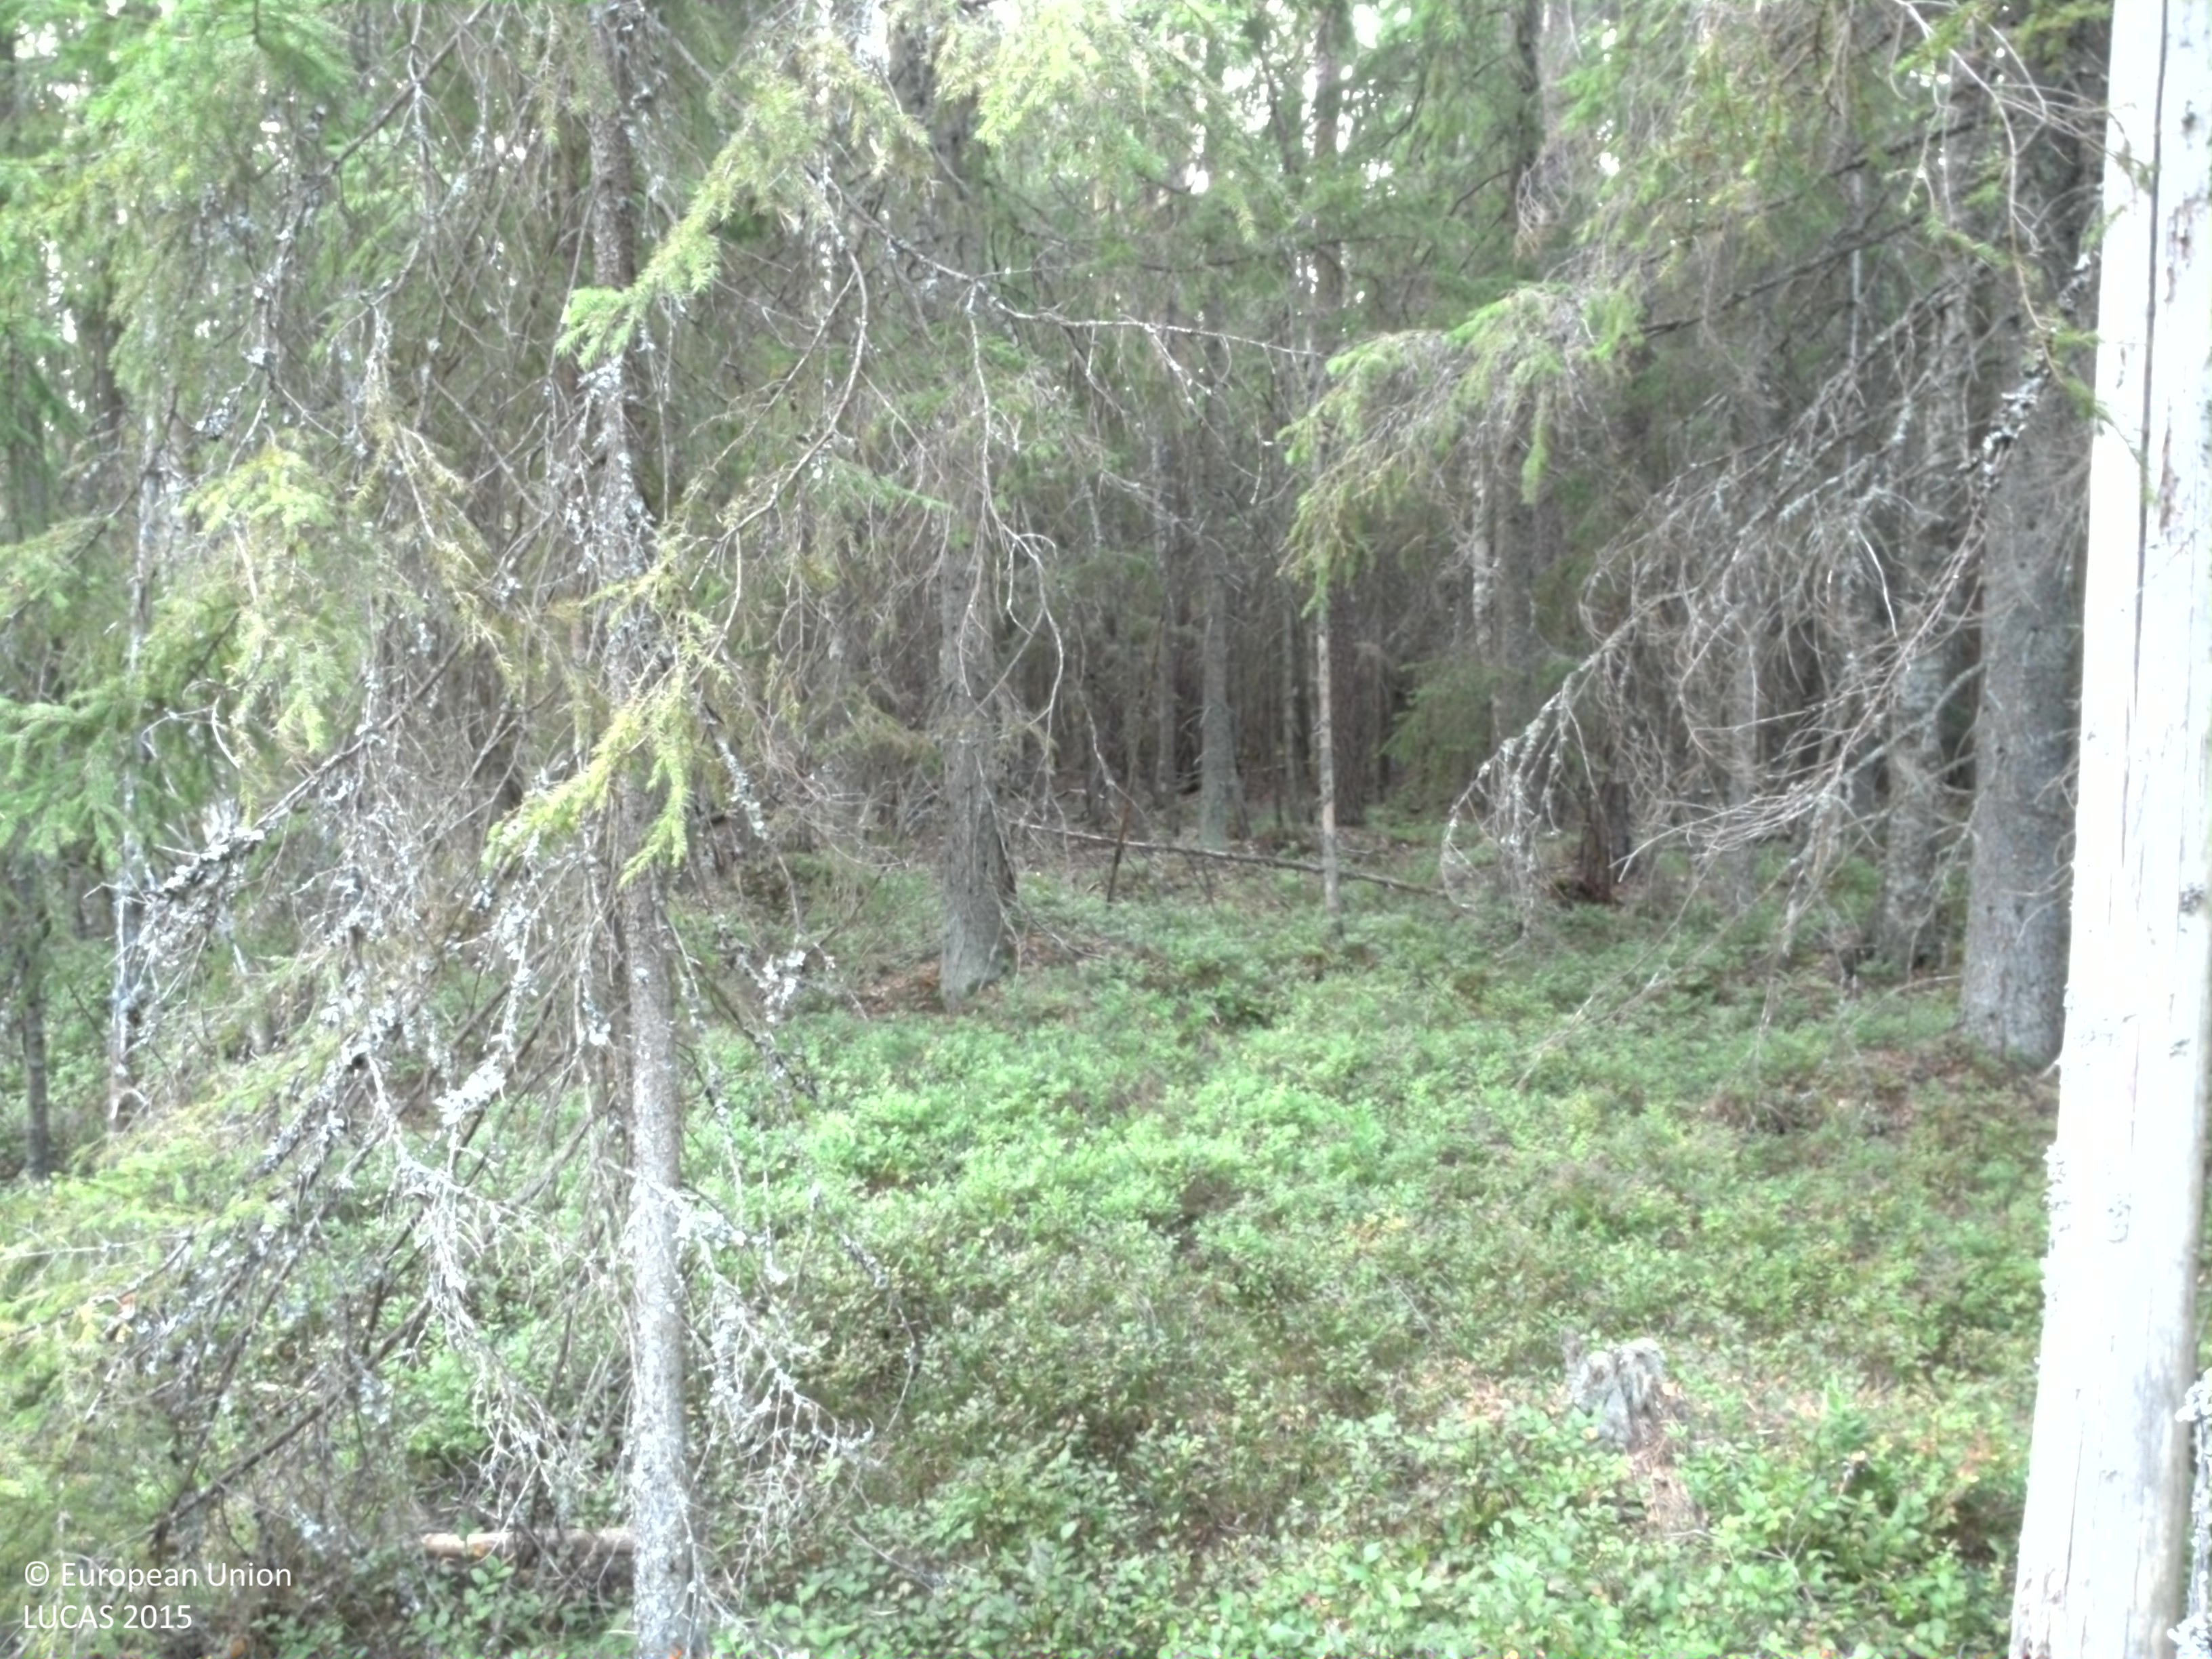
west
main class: Woodland
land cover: Other coniferous woodland
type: boreal forest
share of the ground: > 75 %
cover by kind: coniferous forest trees 60 %, broadleaved forest trees 15 %, shrubs 15 %, herbaceous plants 5 %, lichens and mosses 5 %
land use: Forestry
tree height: > 5 m
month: August
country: SE
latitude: 59.8466
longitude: 15.7549
